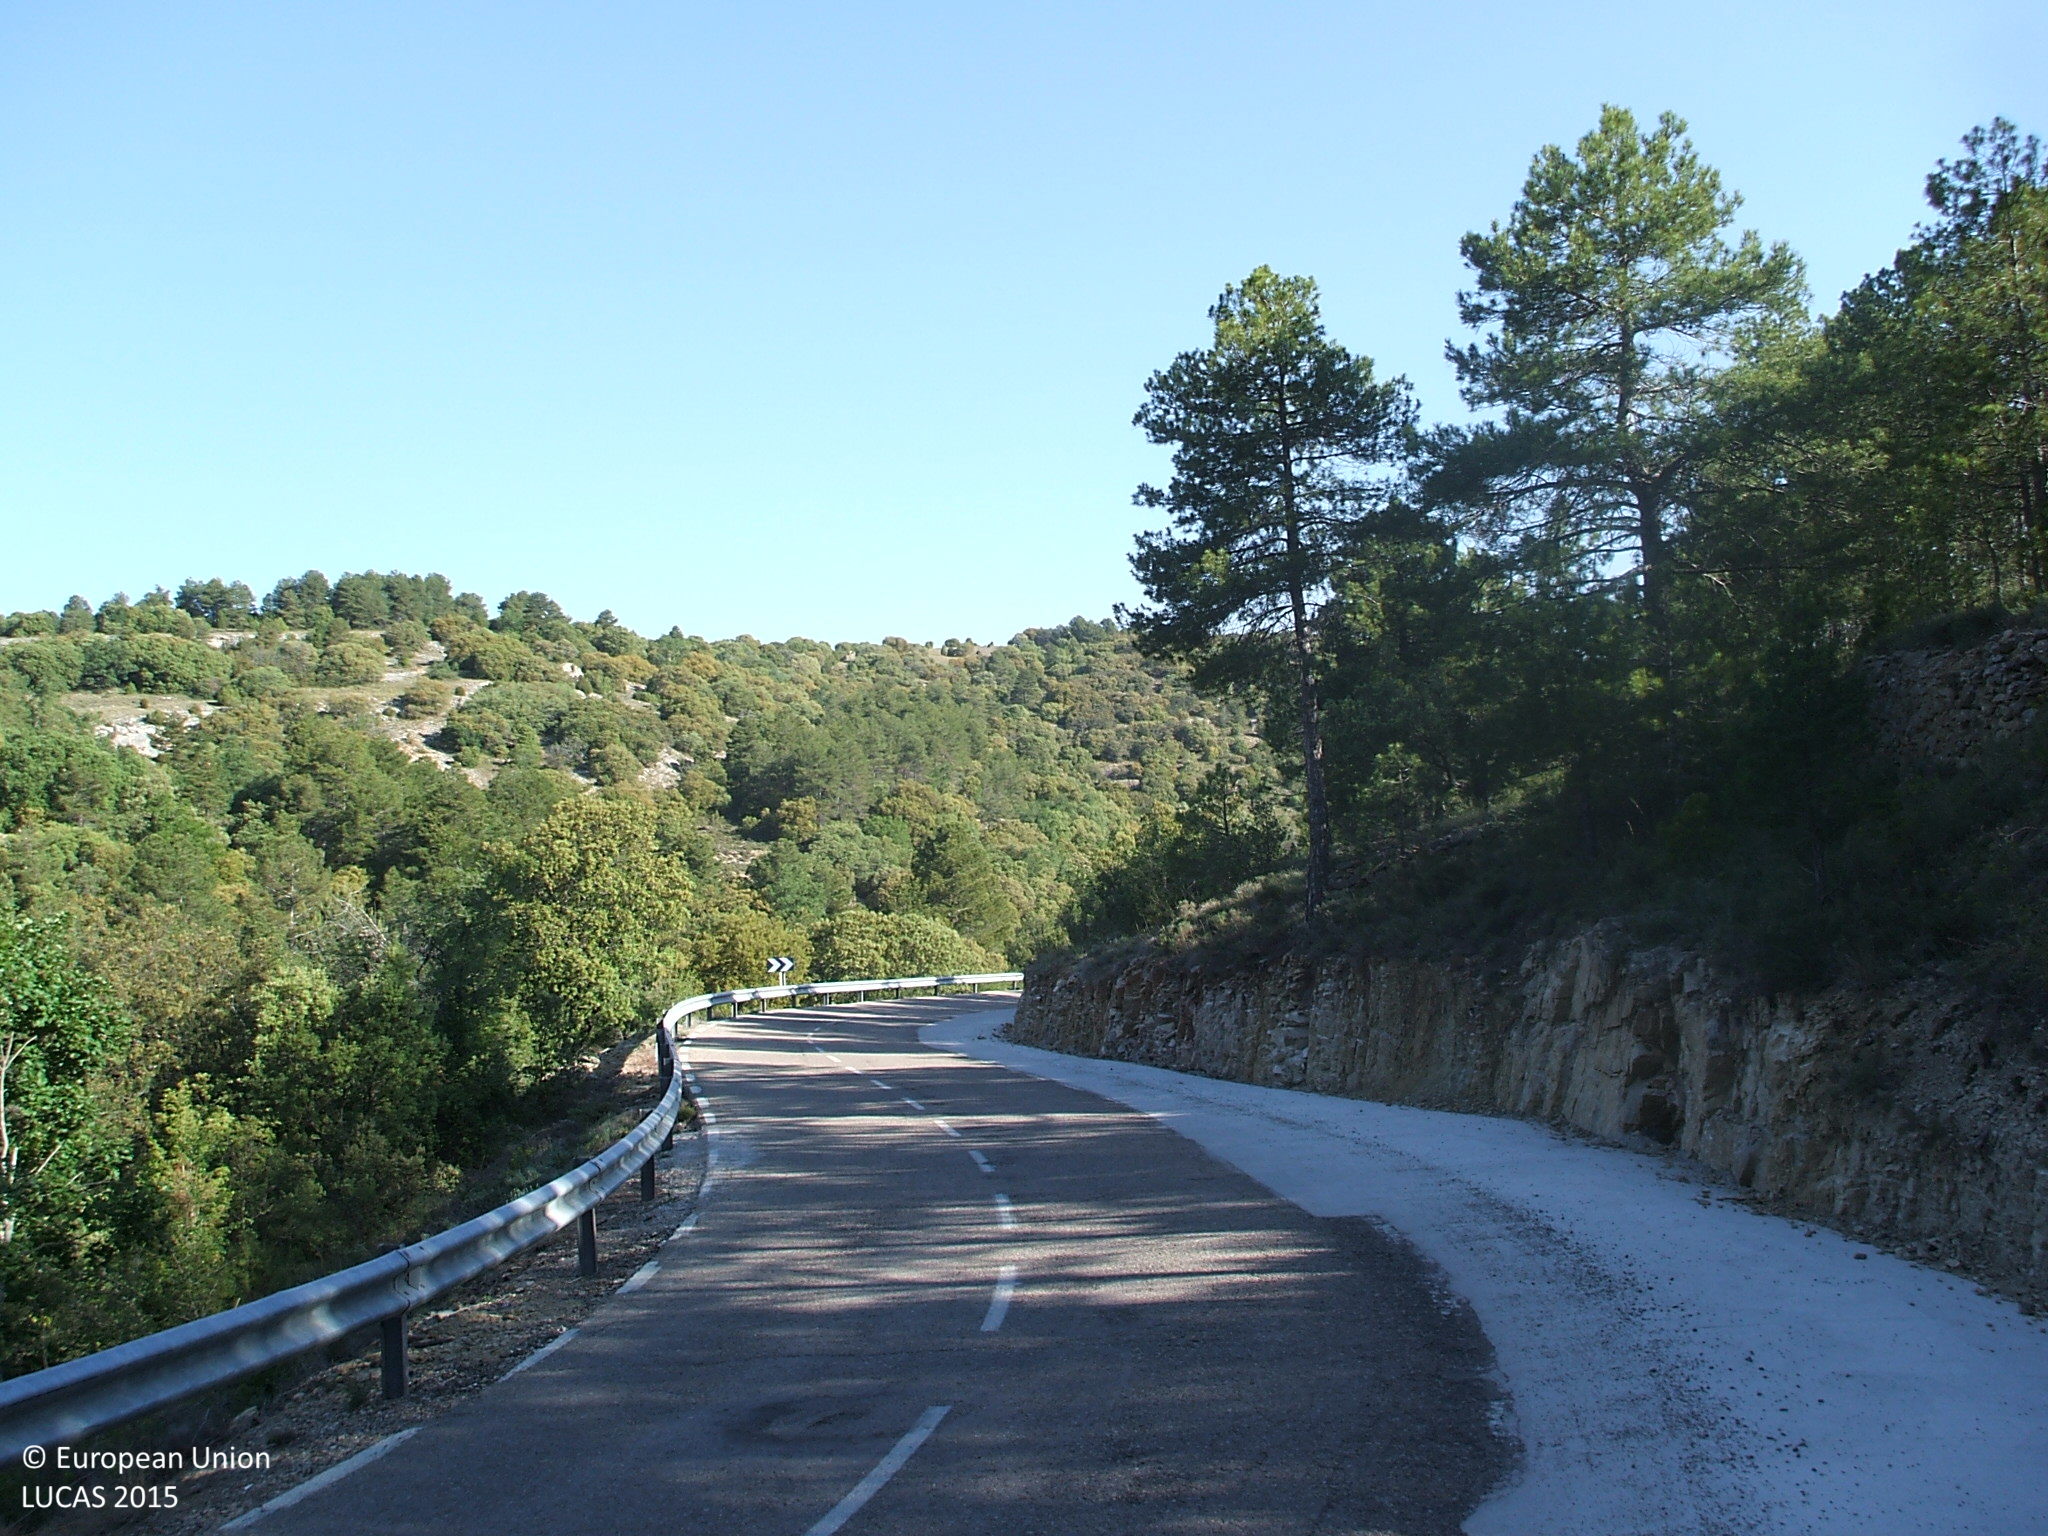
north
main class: Woodland
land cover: Pine dominated mixed woodland
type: coniferous forest of the mediterranean region
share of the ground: 50 - 75 %
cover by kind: herbaceous plants 40 %, coniferous forest trees 35 %, broadleaved forest trees 25 %
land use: Semi-natural and natural areas not in use
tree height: > 5 m
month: May
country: ES
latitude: 40.5674
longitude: -0.2482
